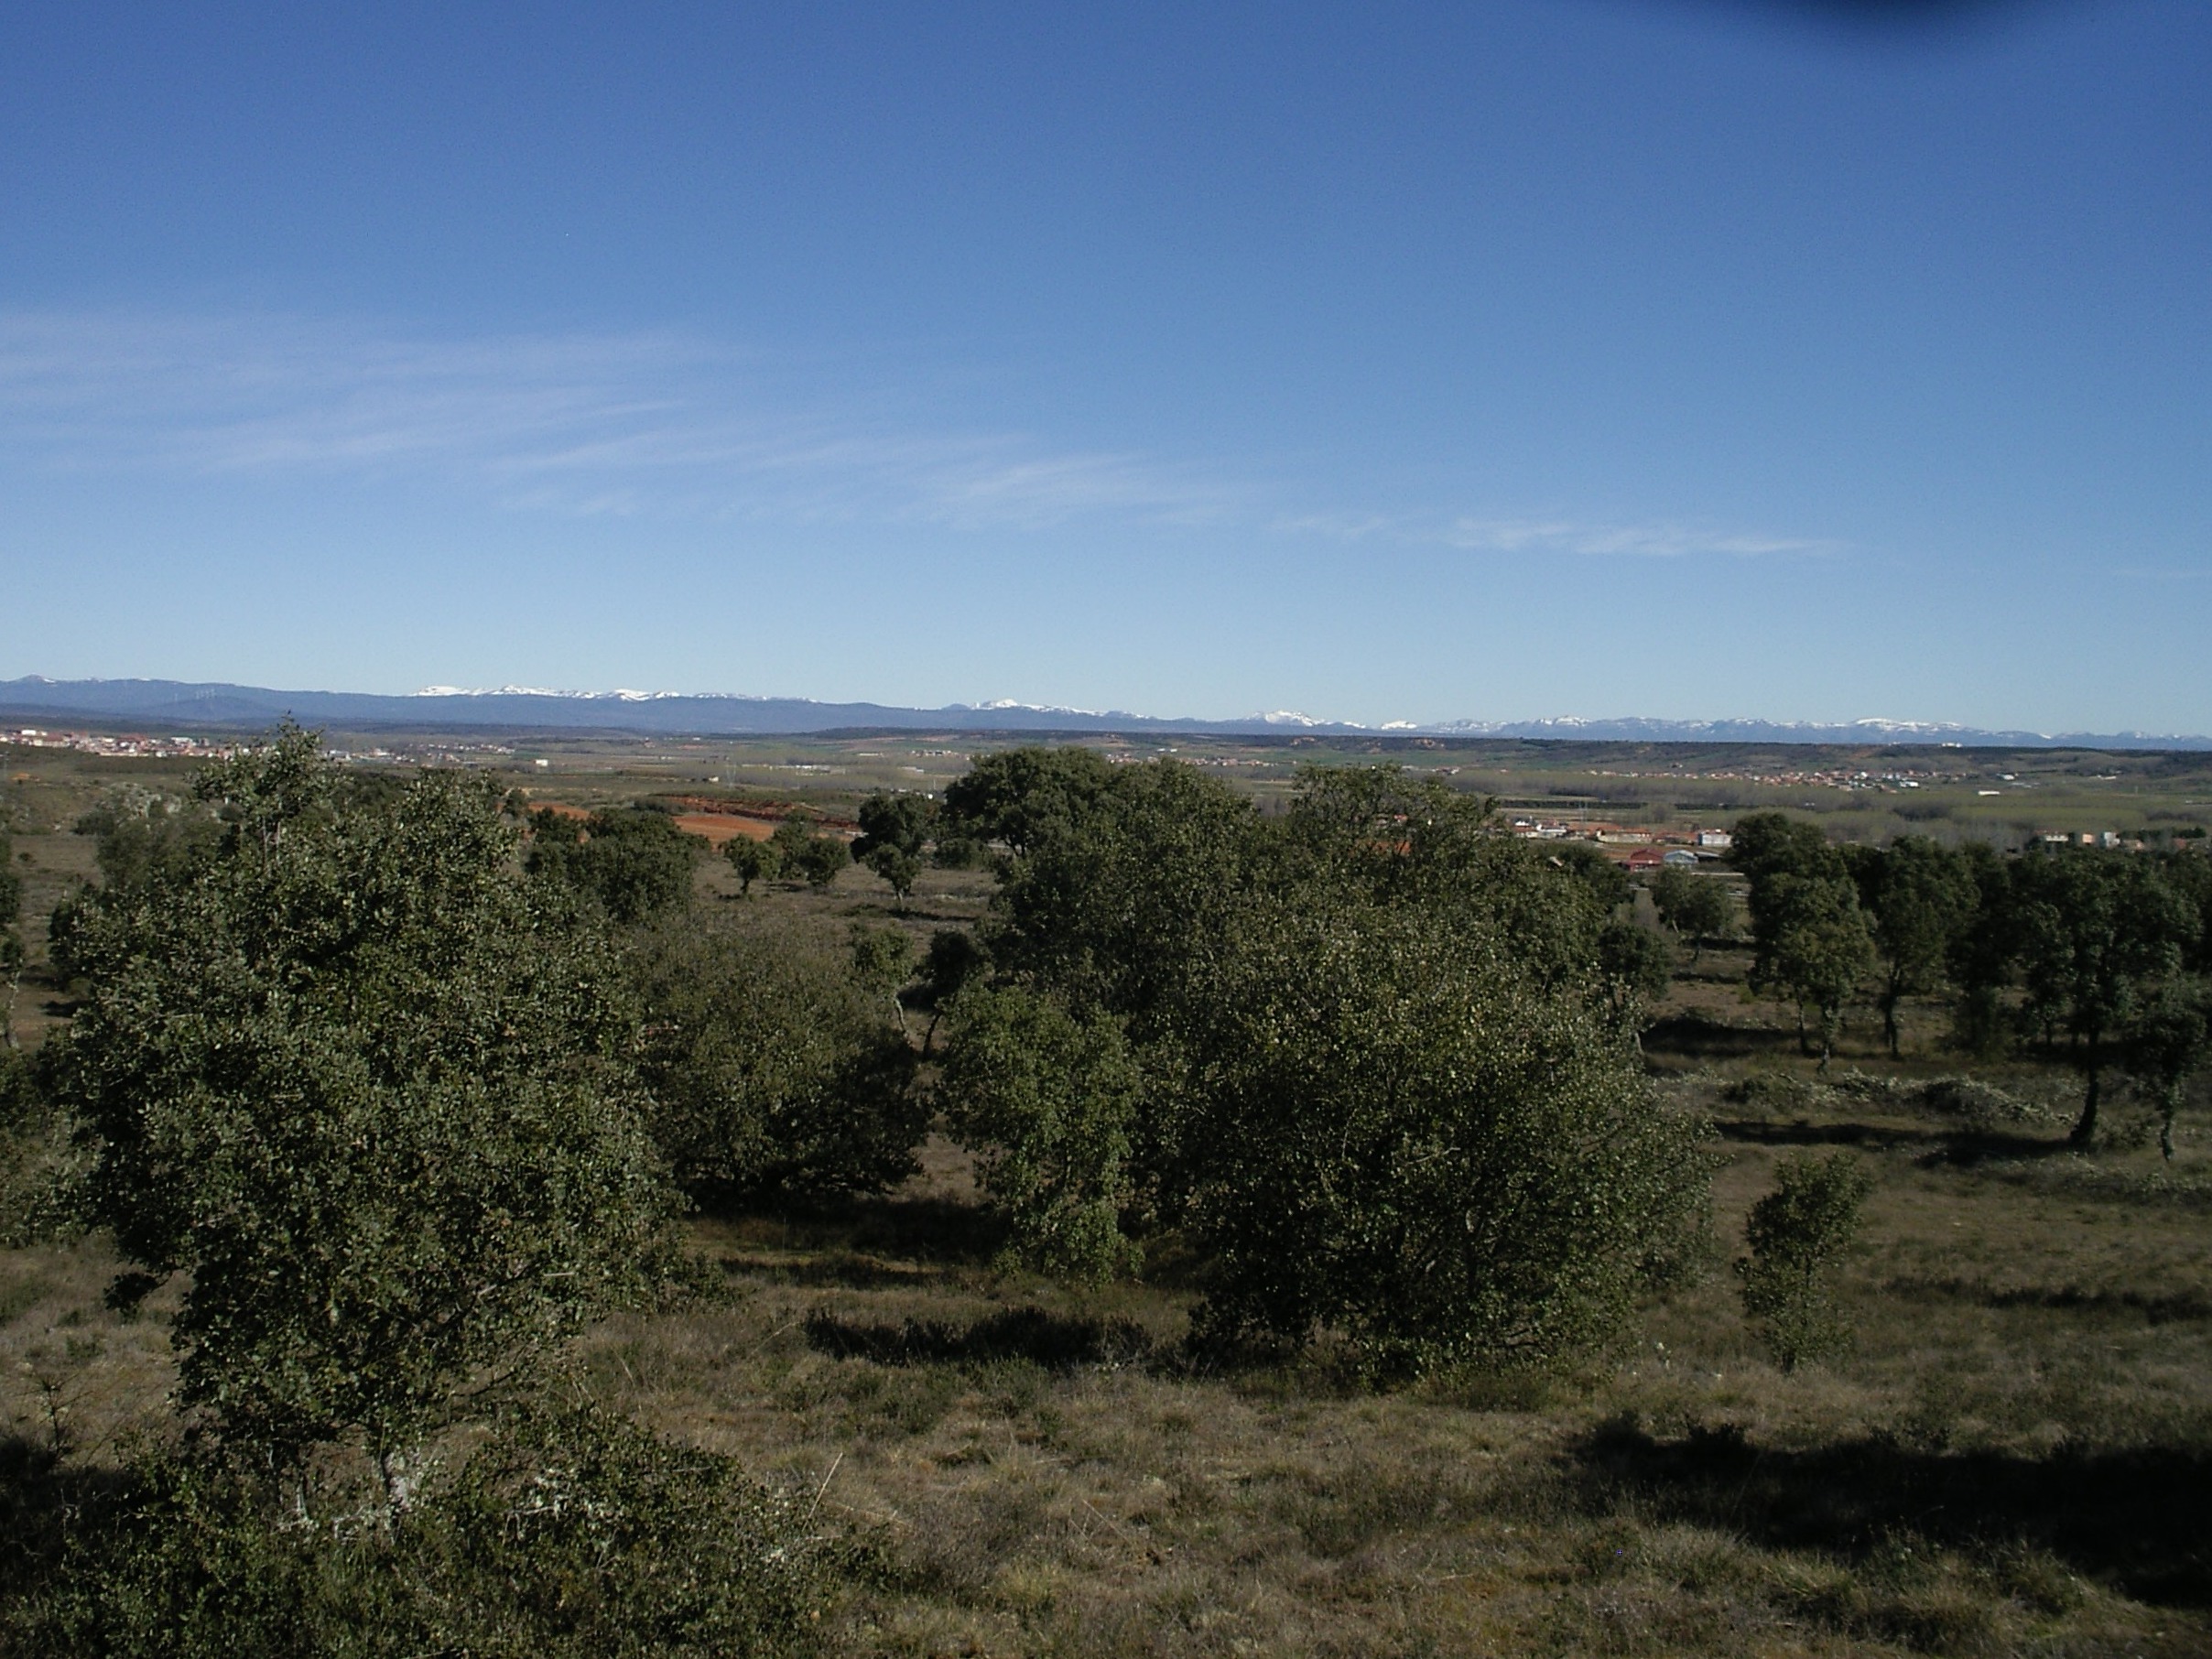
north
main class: Woodland
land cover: Broadleaved woodland
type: broadleaved evergreen forest
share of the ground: 10 - 25 %
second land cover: Grassland without tree/shrub cover
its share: > 75 %
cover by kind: herbaceous plants 80 %, broadleaved forest trees 15 %, shrubs 5 %
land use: Forestry
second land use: Agriculture (excluding fallow land and kitchen gardens)
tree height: > 5 m
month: March
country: ES
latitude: 42.4140
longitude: -6.0360
